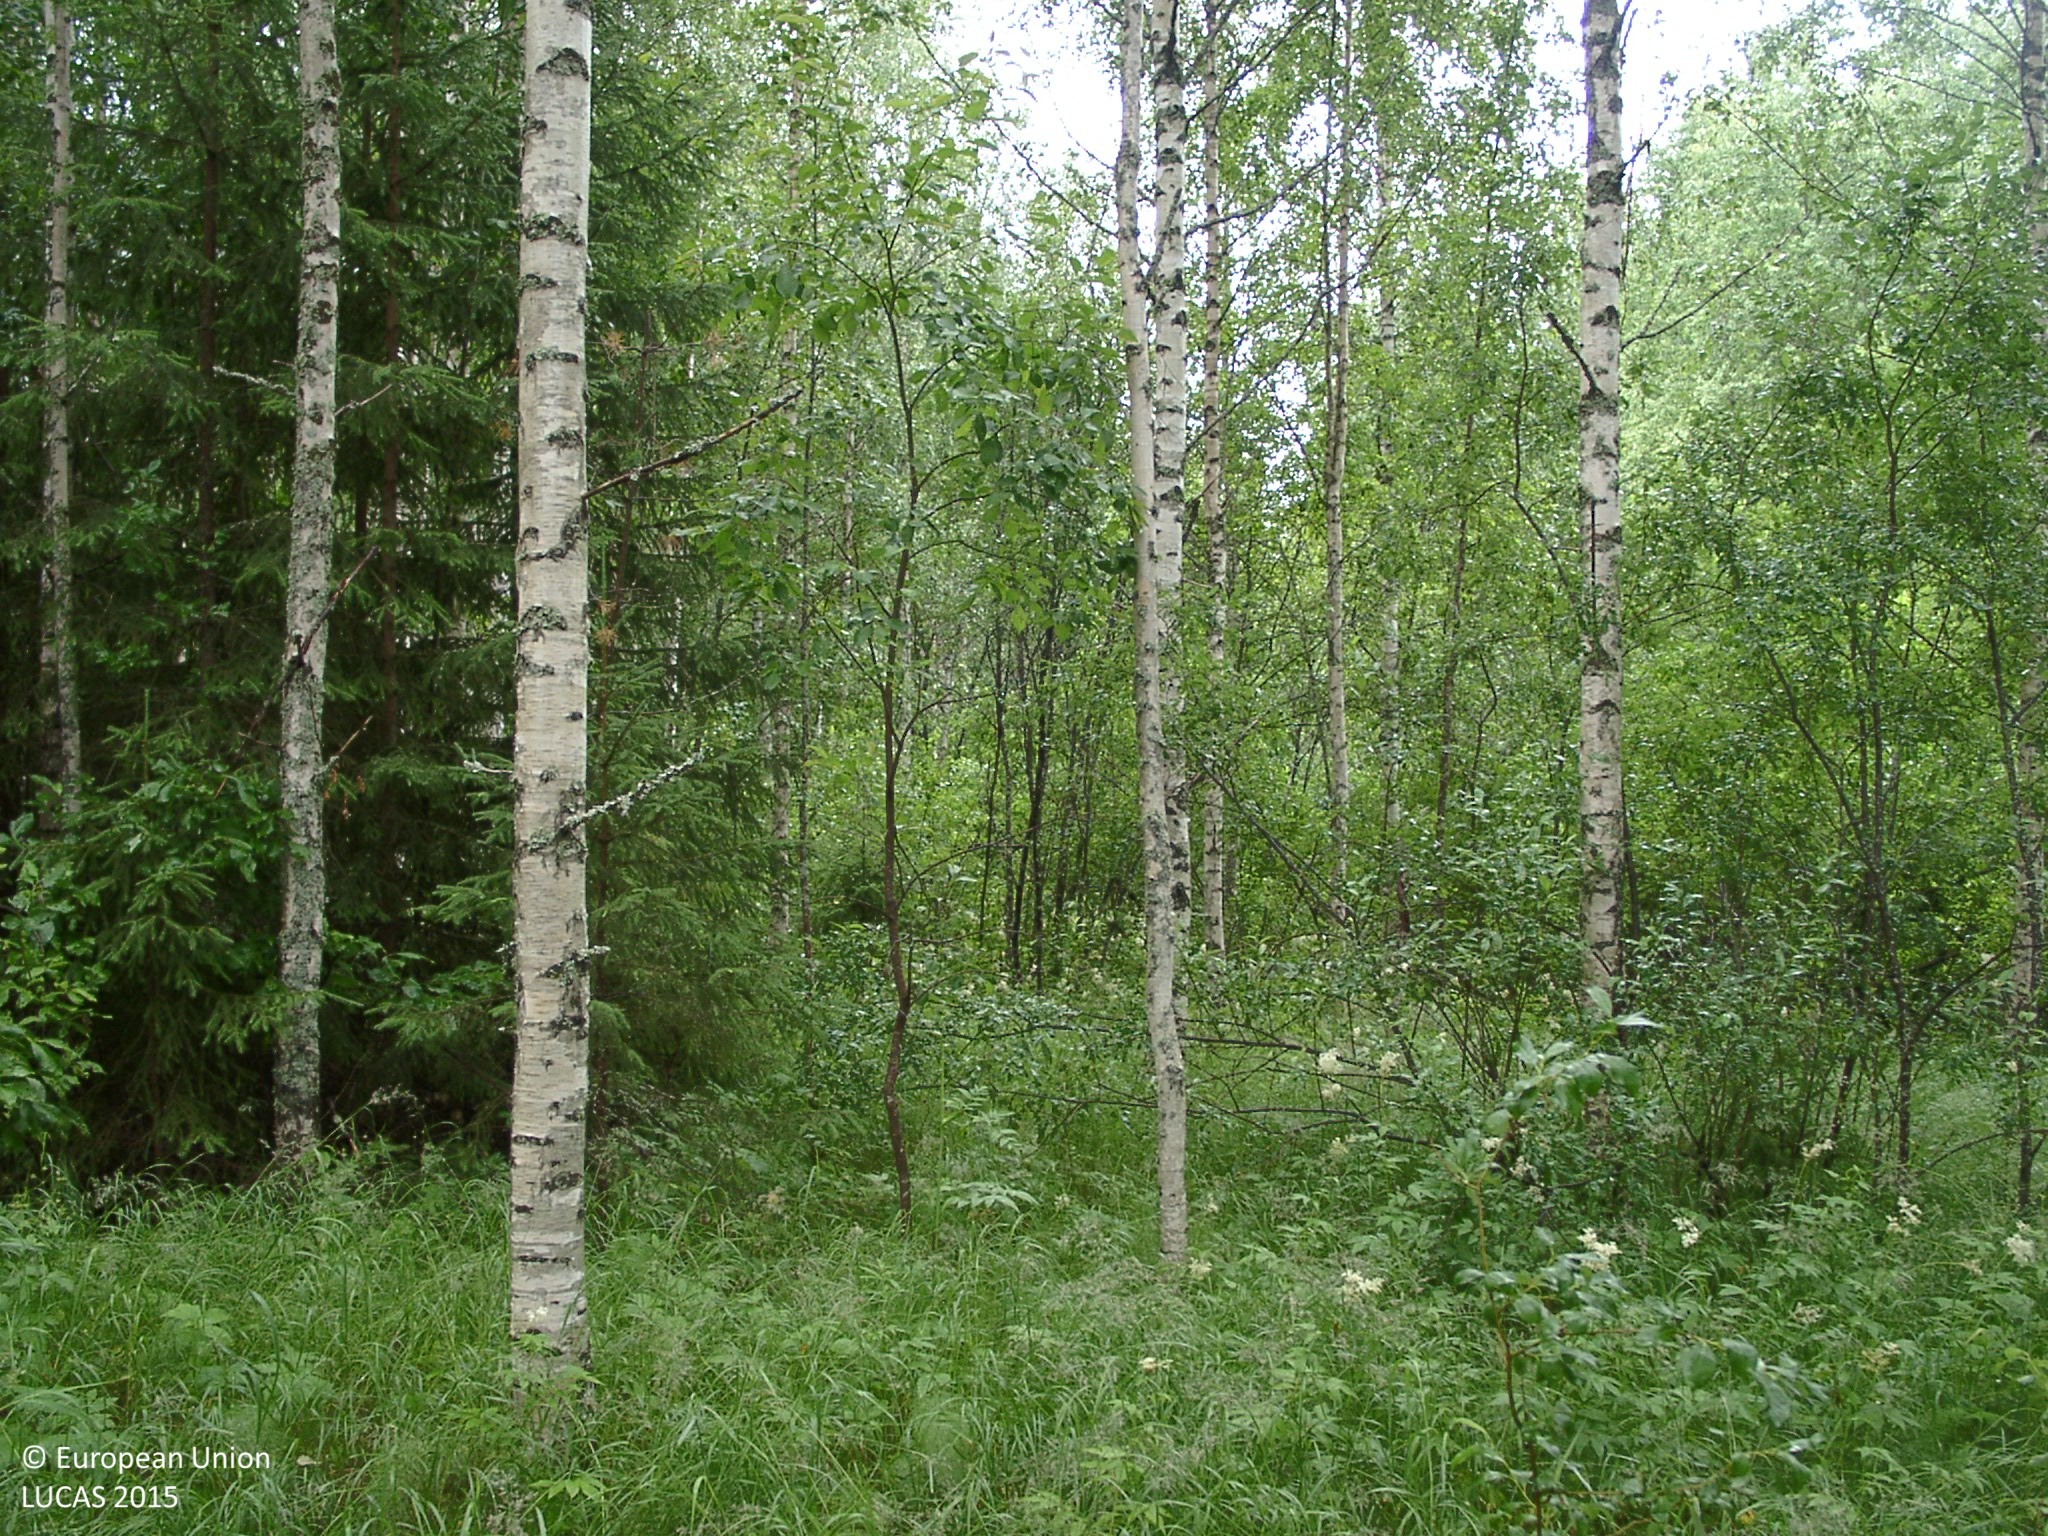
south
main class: Woodland
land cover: Broadleaved woodland
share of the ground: 50 - 75 %
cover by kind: broadleaved forest trees 60 %, herbaceous plants 30 %, shrubs 10 %
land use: Semi-natural and natural areas not in use
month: July
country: FI
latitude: 62.2512
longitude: 25.6152
